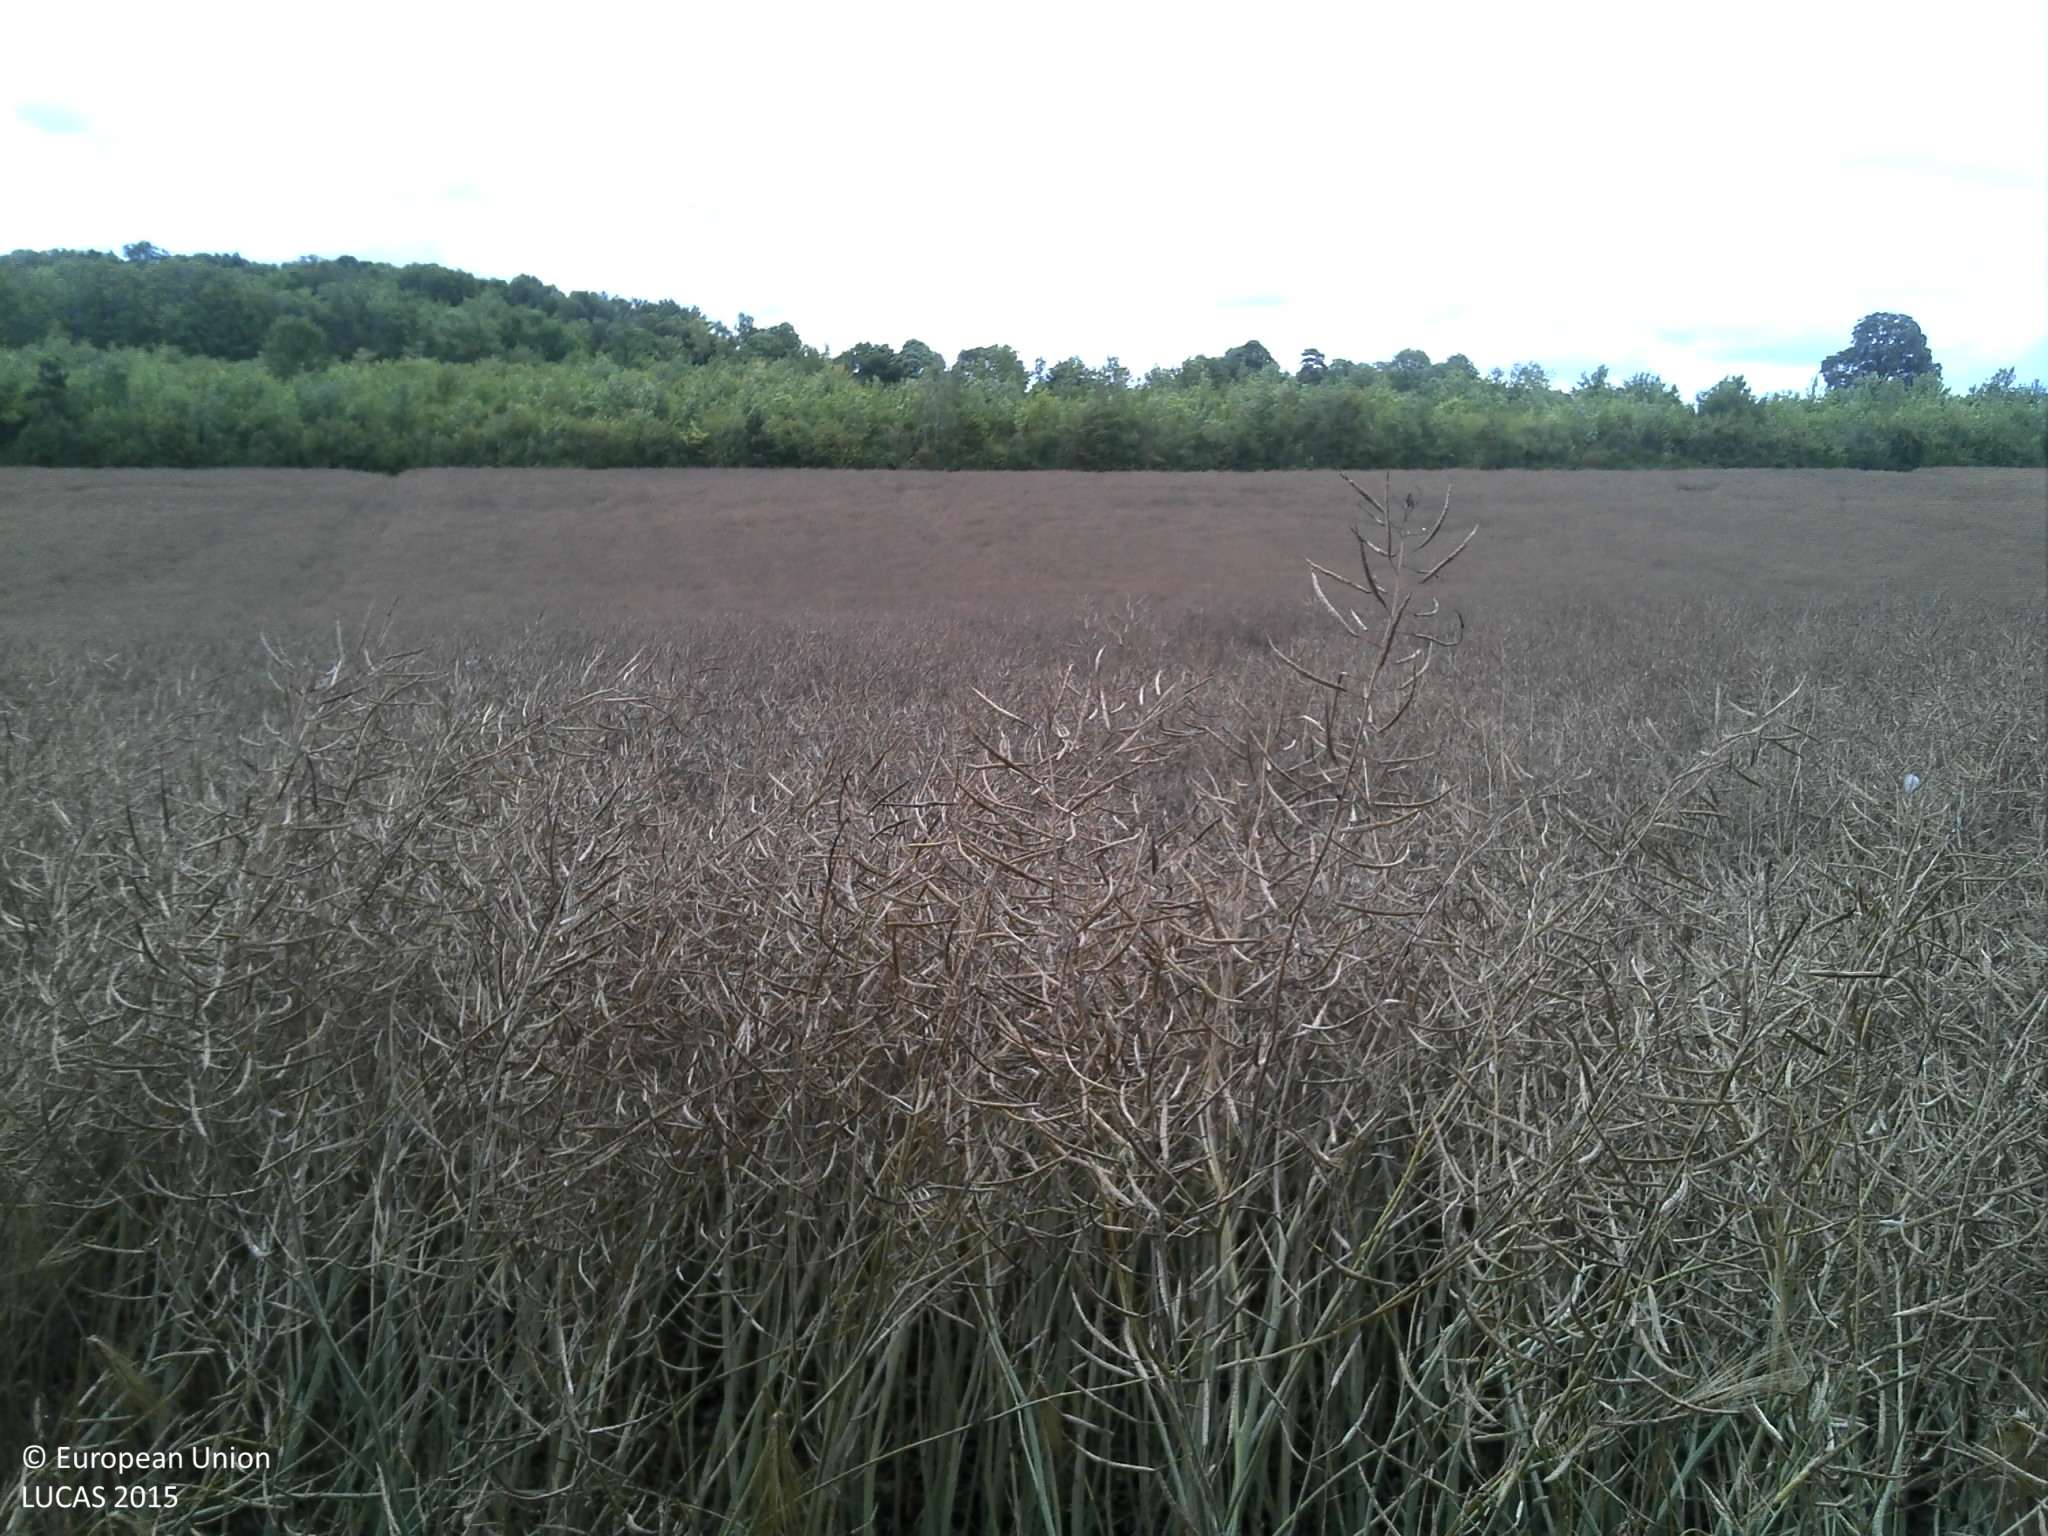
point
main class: Cropland
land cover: Rape and turnip rape
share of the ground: > 75 %
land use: Agriculture (excluding fallow land and kitchen gardens)
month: July
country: FR
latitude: 49.5472
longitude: 4.1487
